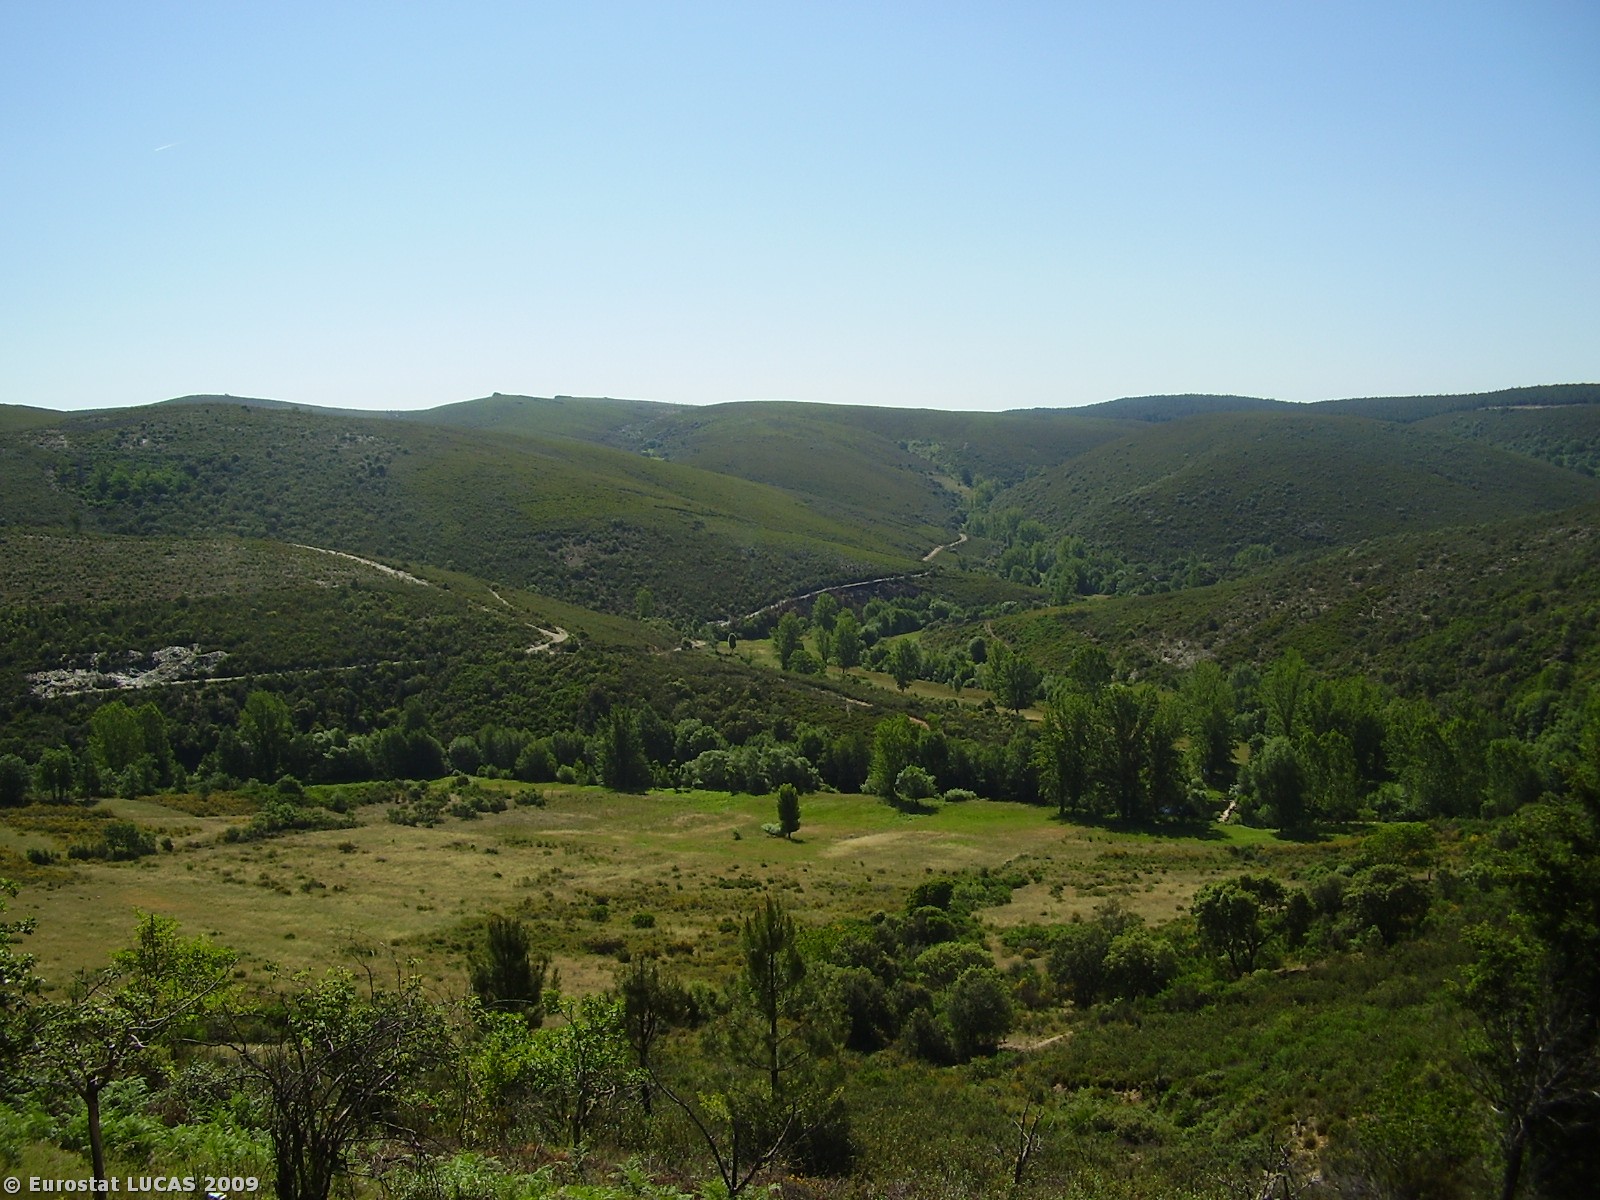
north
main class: Grassland
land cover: Spontaneously vegetated surfaces
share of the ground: > 75 %
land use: Nature reserves
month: June
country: PT
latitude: 41.9317
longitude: -6.6218
